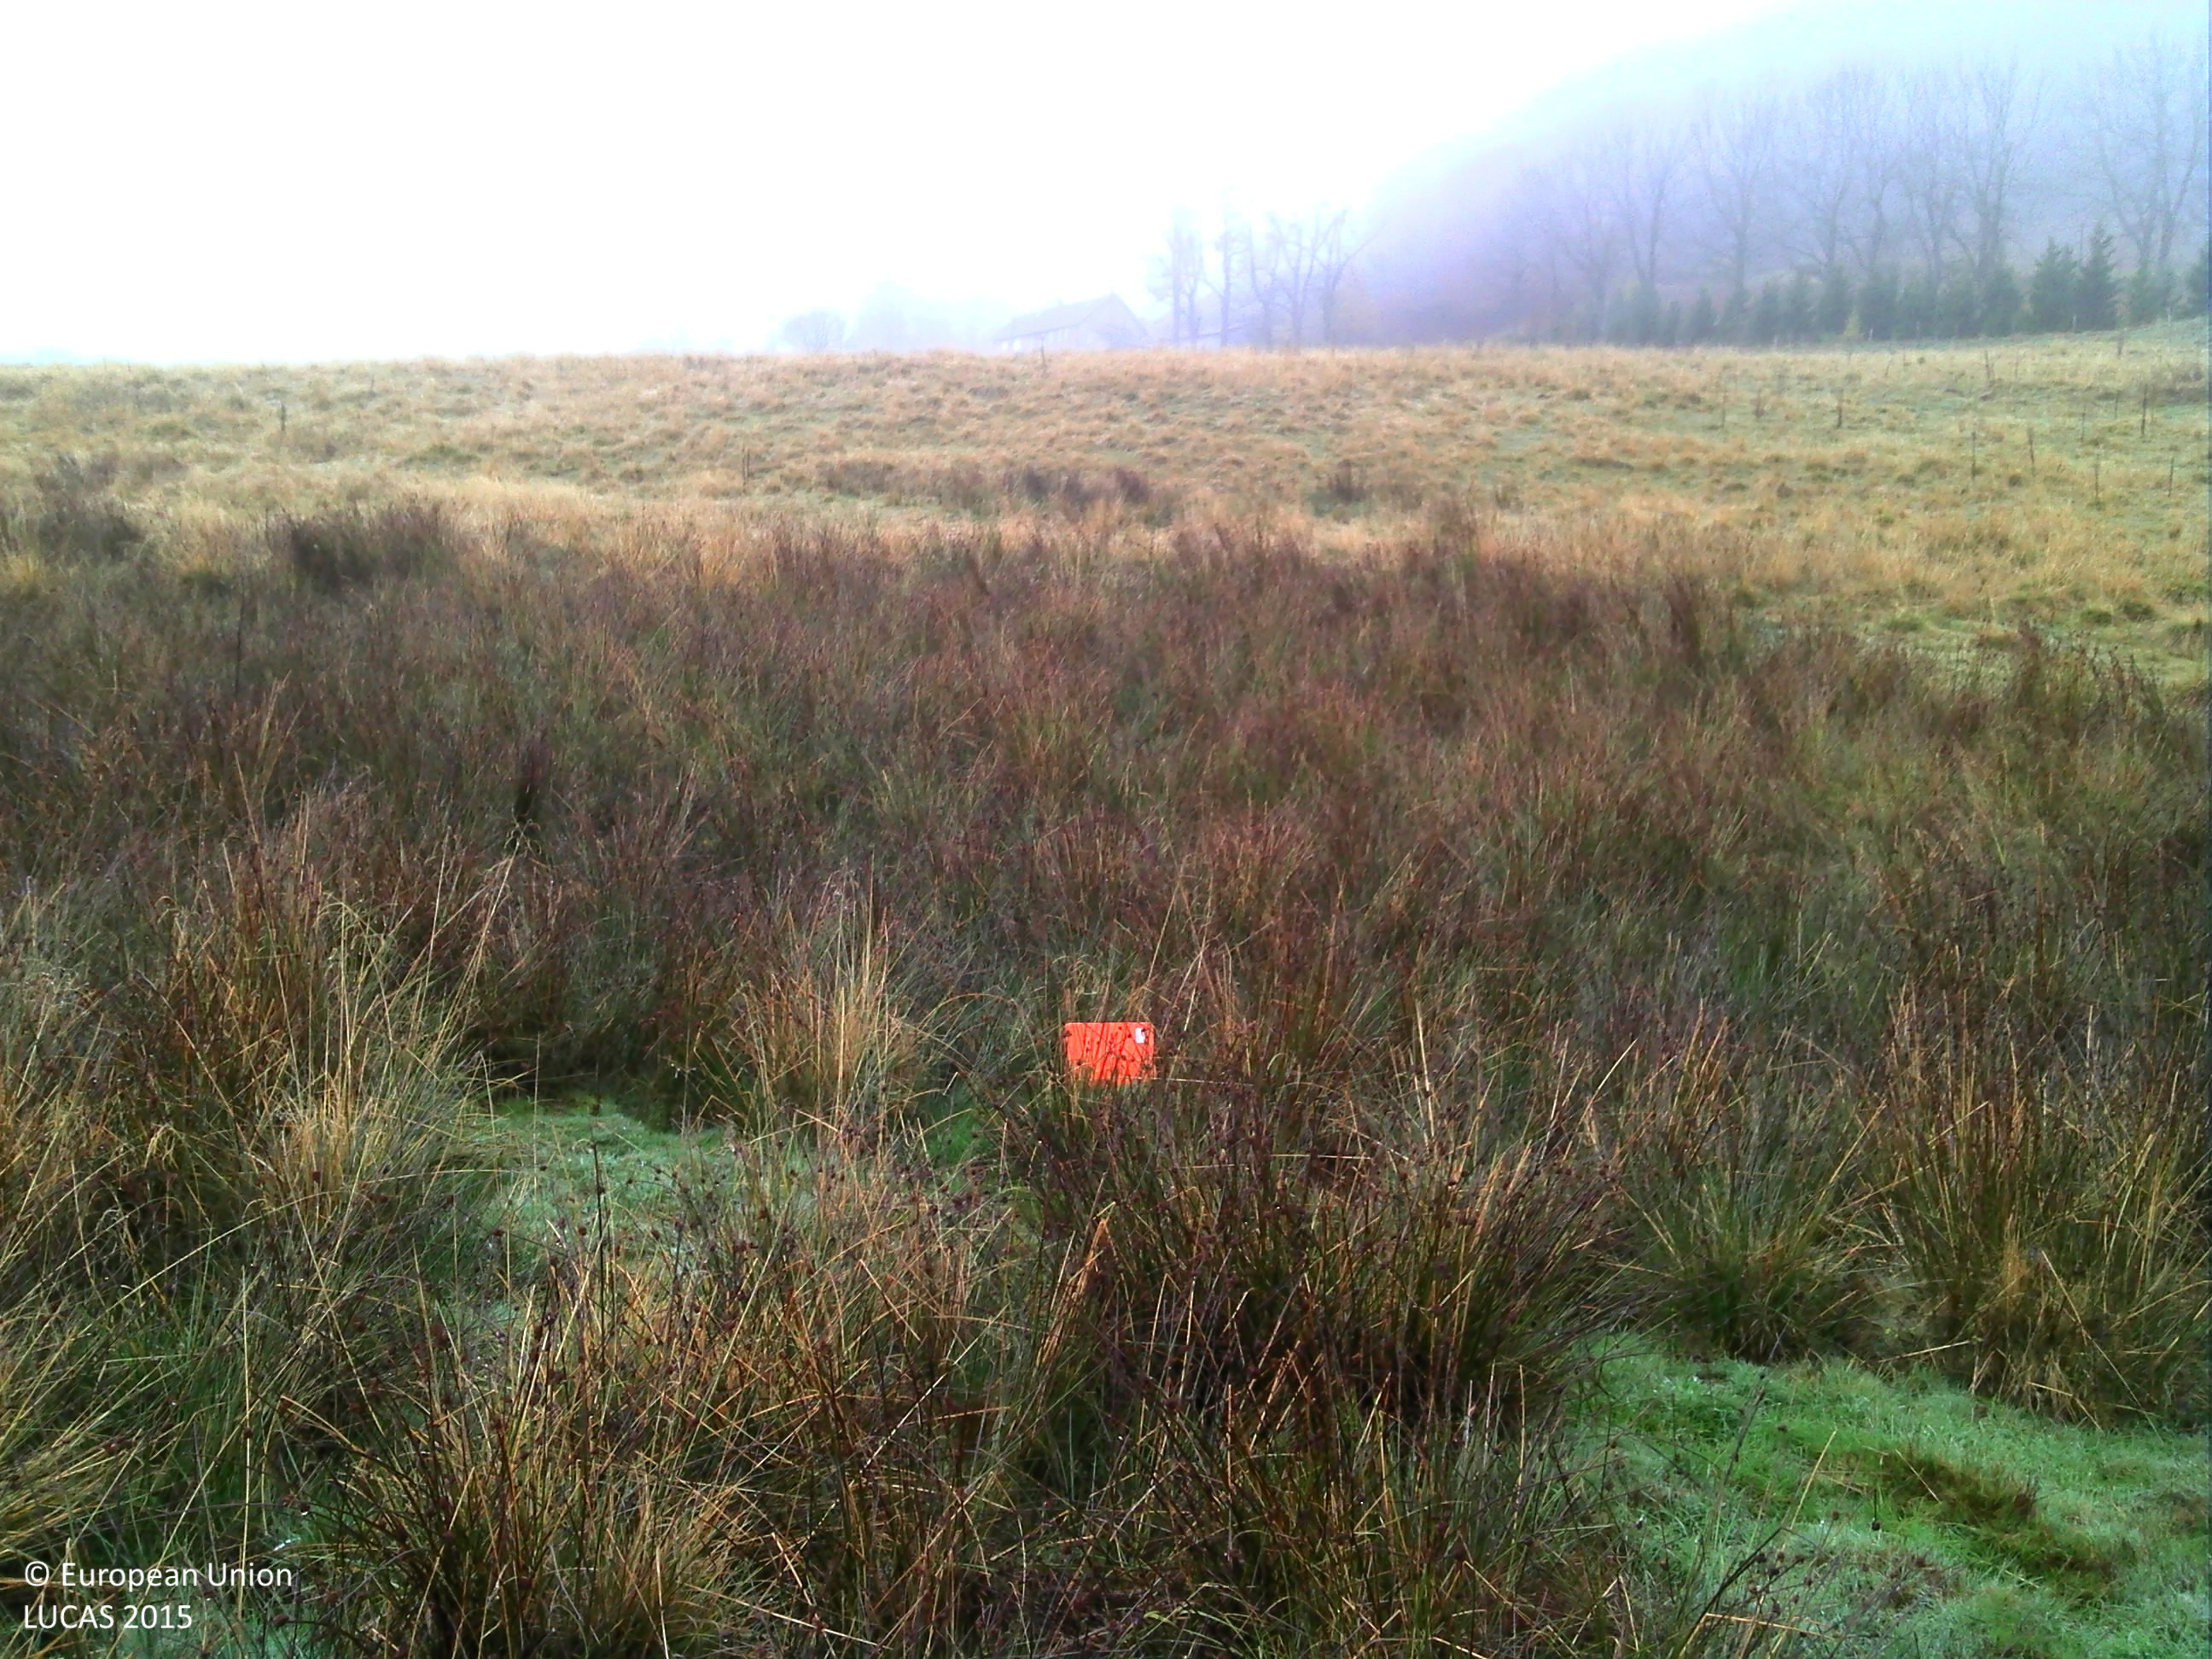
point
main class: Grassland
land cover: Grassland without tree/shrub cover
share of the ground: > 75 %
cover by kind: herbaceous plants 100 %
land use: Agriculture (excluding fallow land and kitchen gardens)
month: October
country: FR
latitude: 44.9468
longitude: 4.1875
